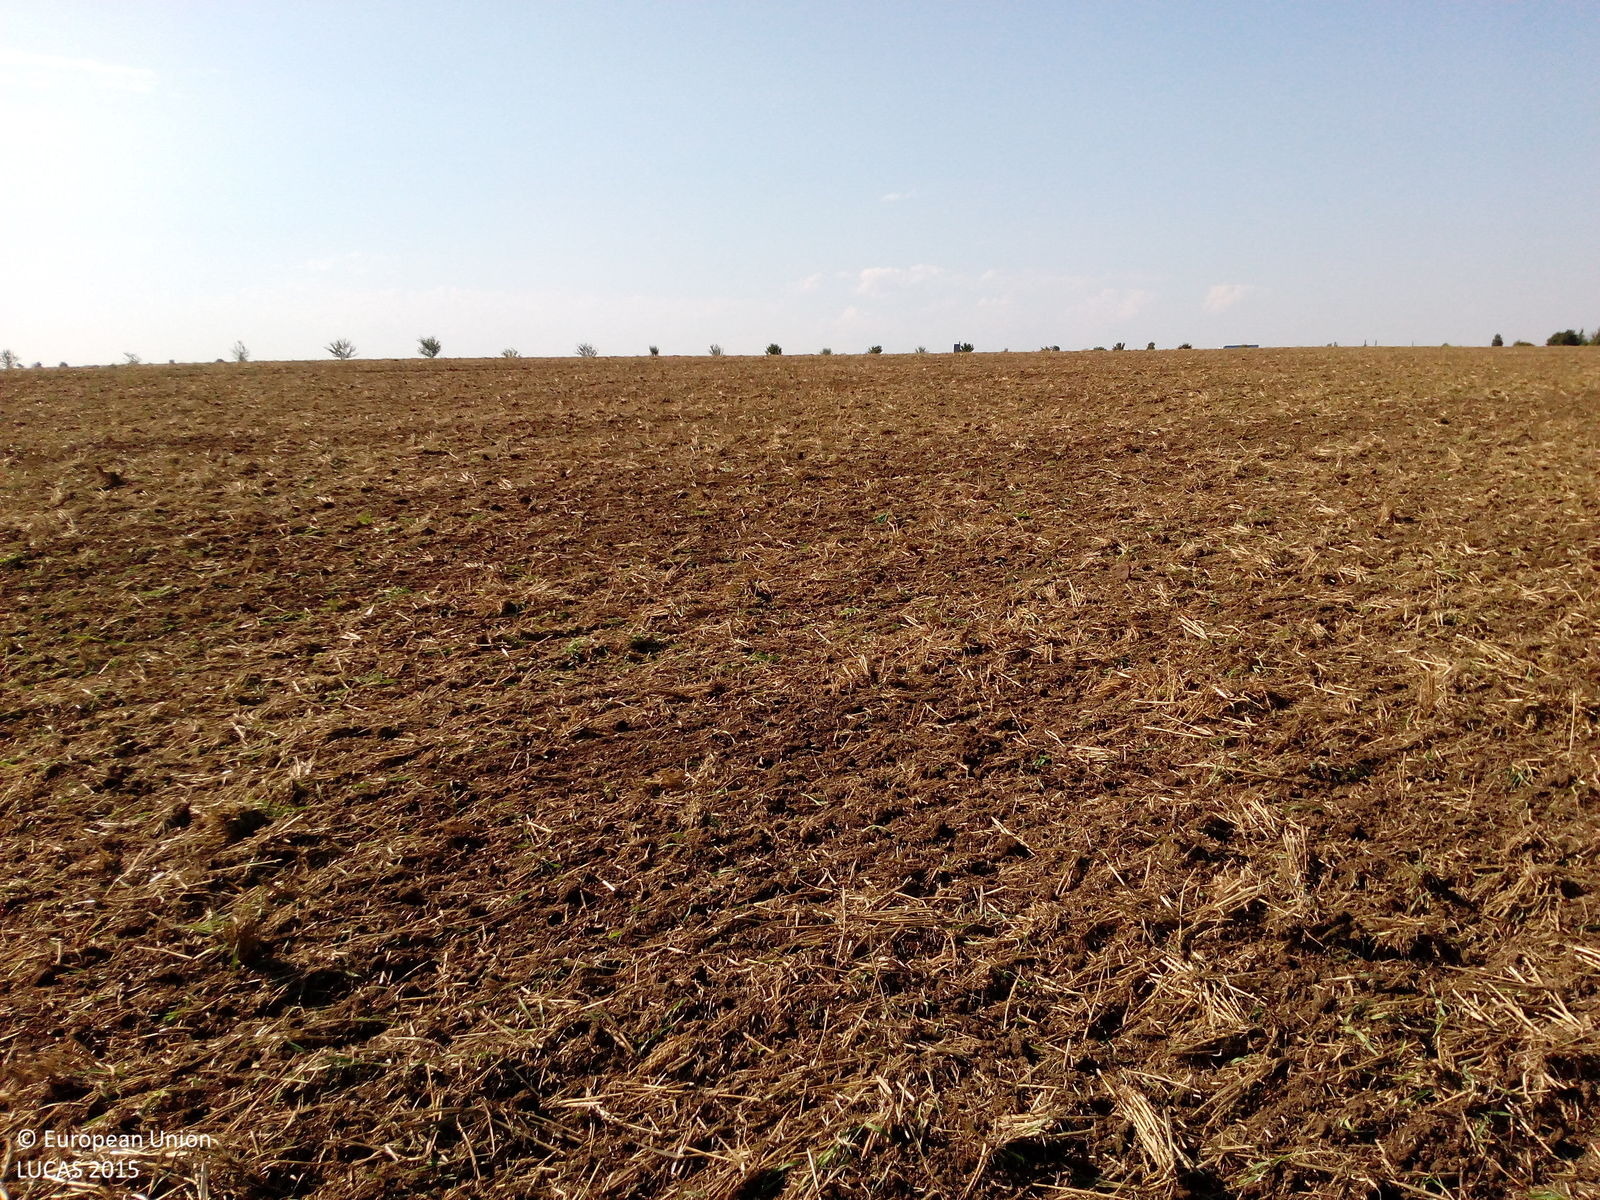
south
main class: Cropland
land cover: Barley
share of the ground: < 10 %
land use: Agriculture (excluding fallow land and kitchen gardens)
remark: Harvested field
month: August
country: DE
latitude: 50.9534
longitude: 10.9535
